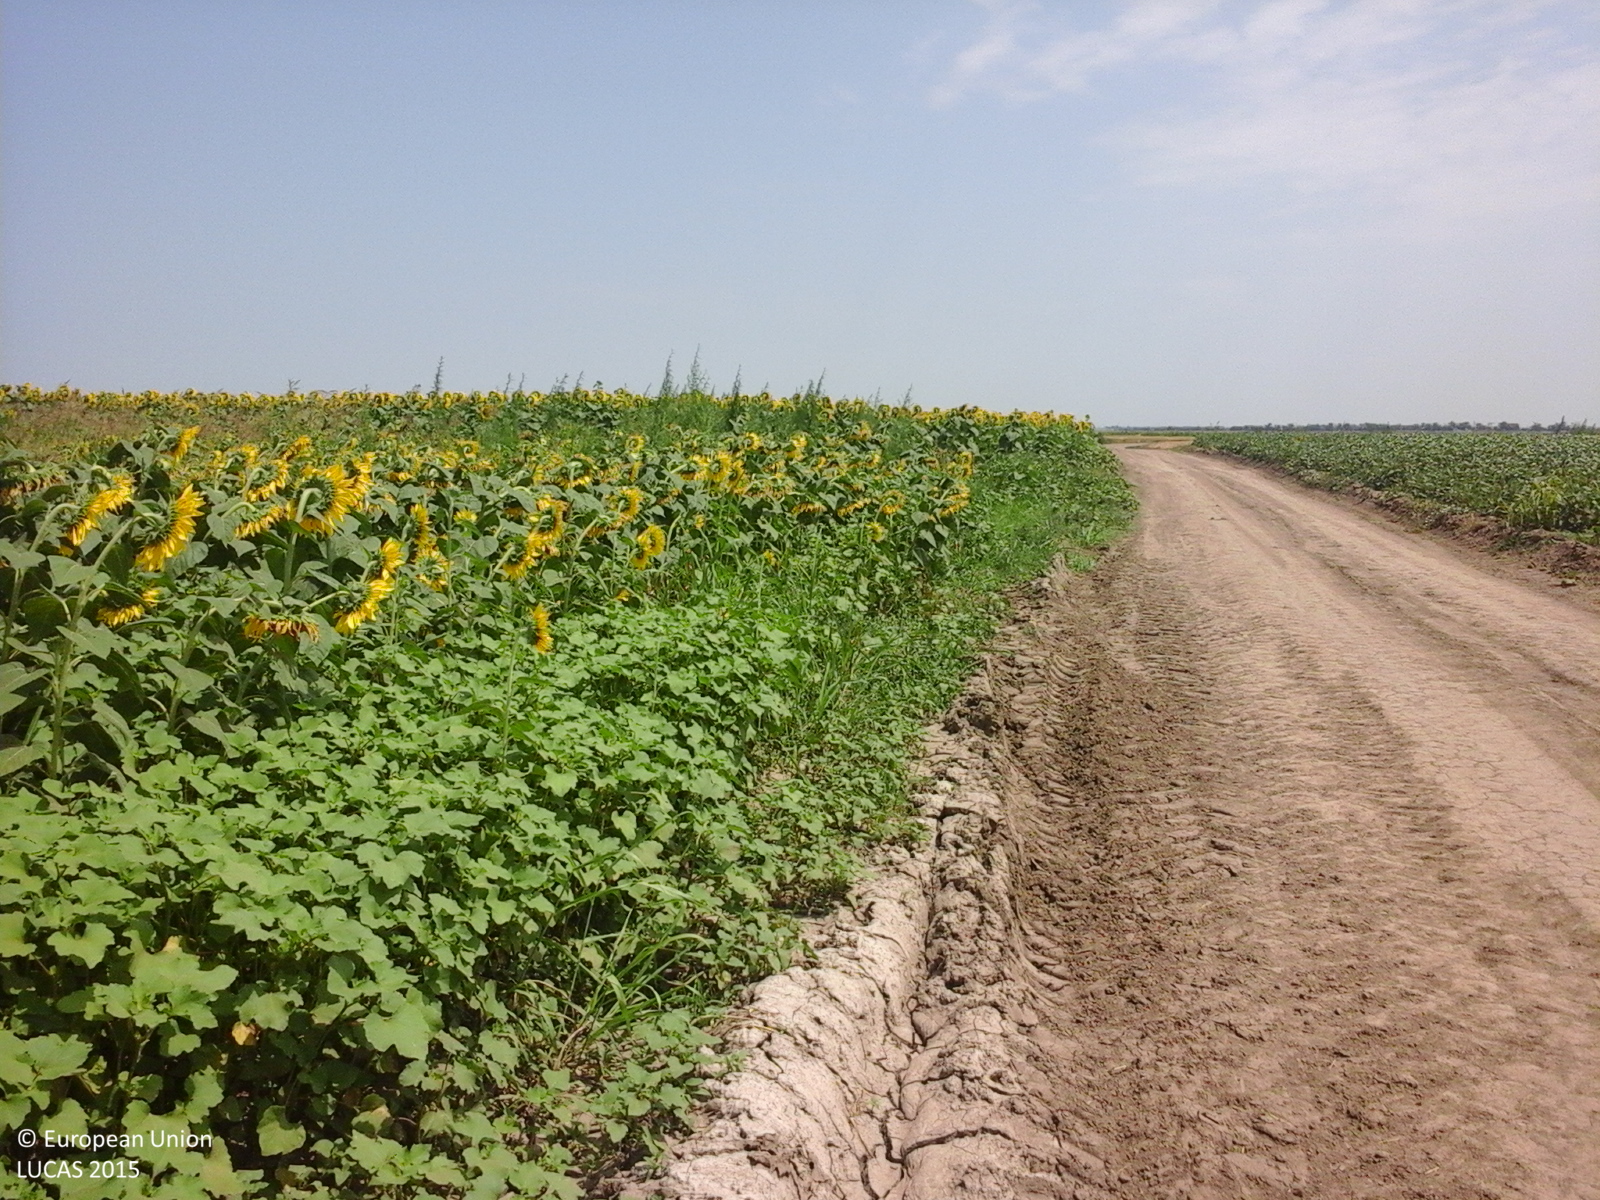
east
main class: Cropland
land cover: Sunflower
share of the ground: > 75 %
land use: Agriculture (excluding fallow land and kitchen gardens)
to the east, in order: Sunflower; Spontaneously vegetated surfaces
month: July
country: RO
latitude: 44.7054
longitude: 27.5256
